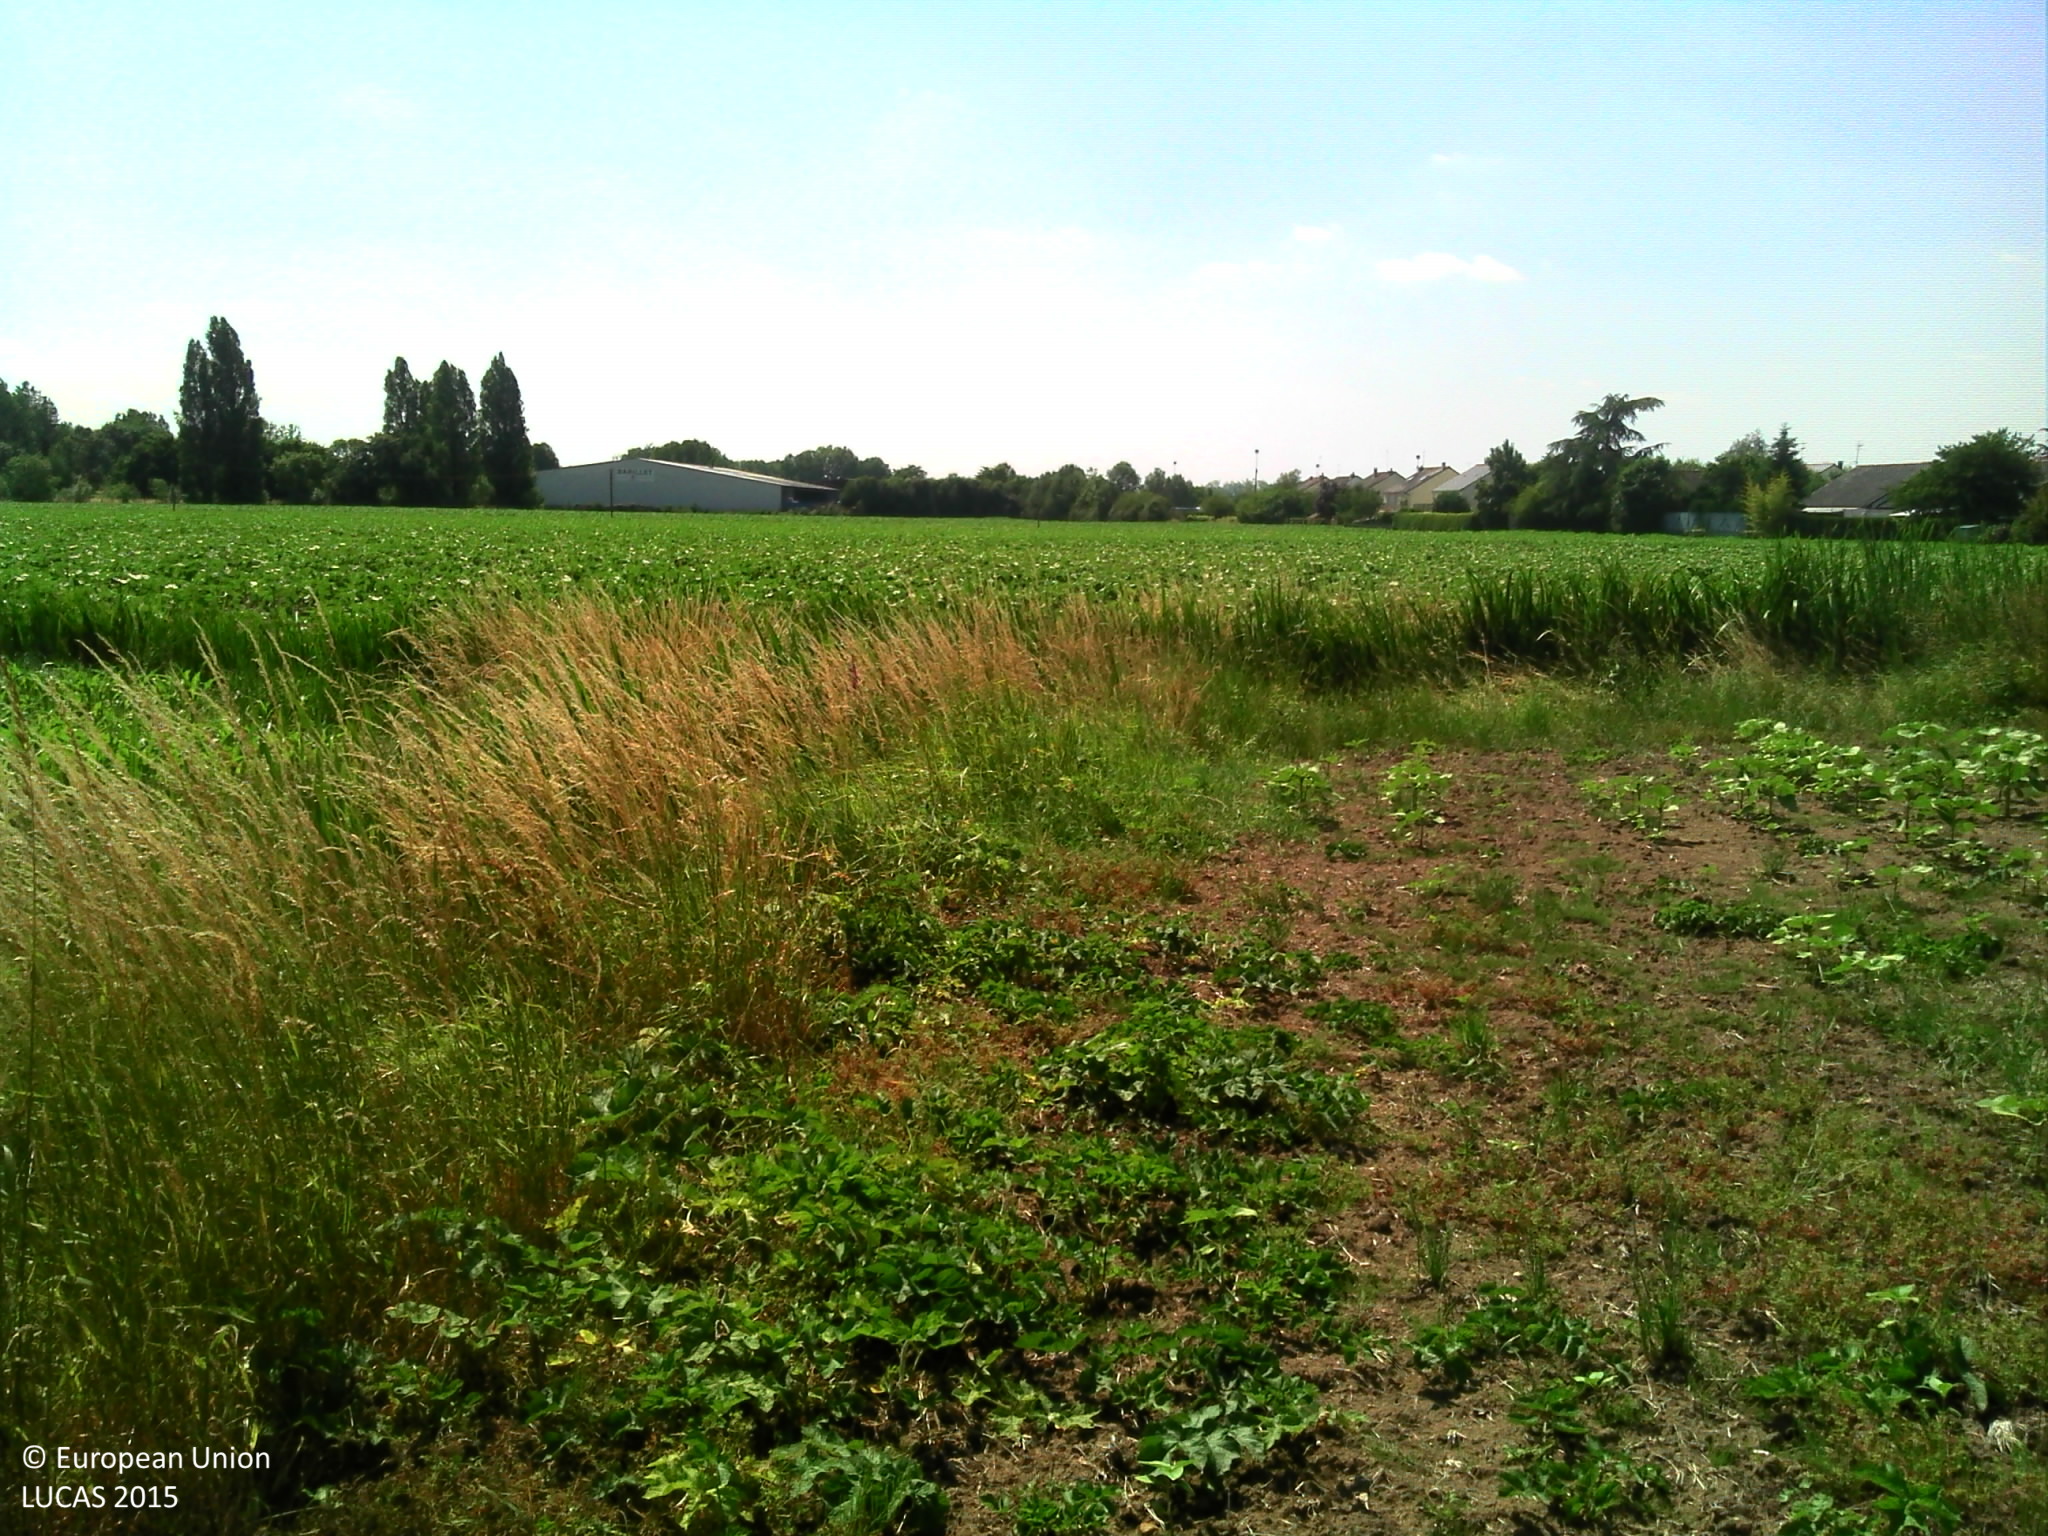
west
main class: Cropland
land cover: Sunflower
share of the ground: 10 - 25 %
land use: Agriculture (excluding fallow land and kitchen gardens)
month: June
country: FR
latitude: 47.3832
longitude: 0.7753
